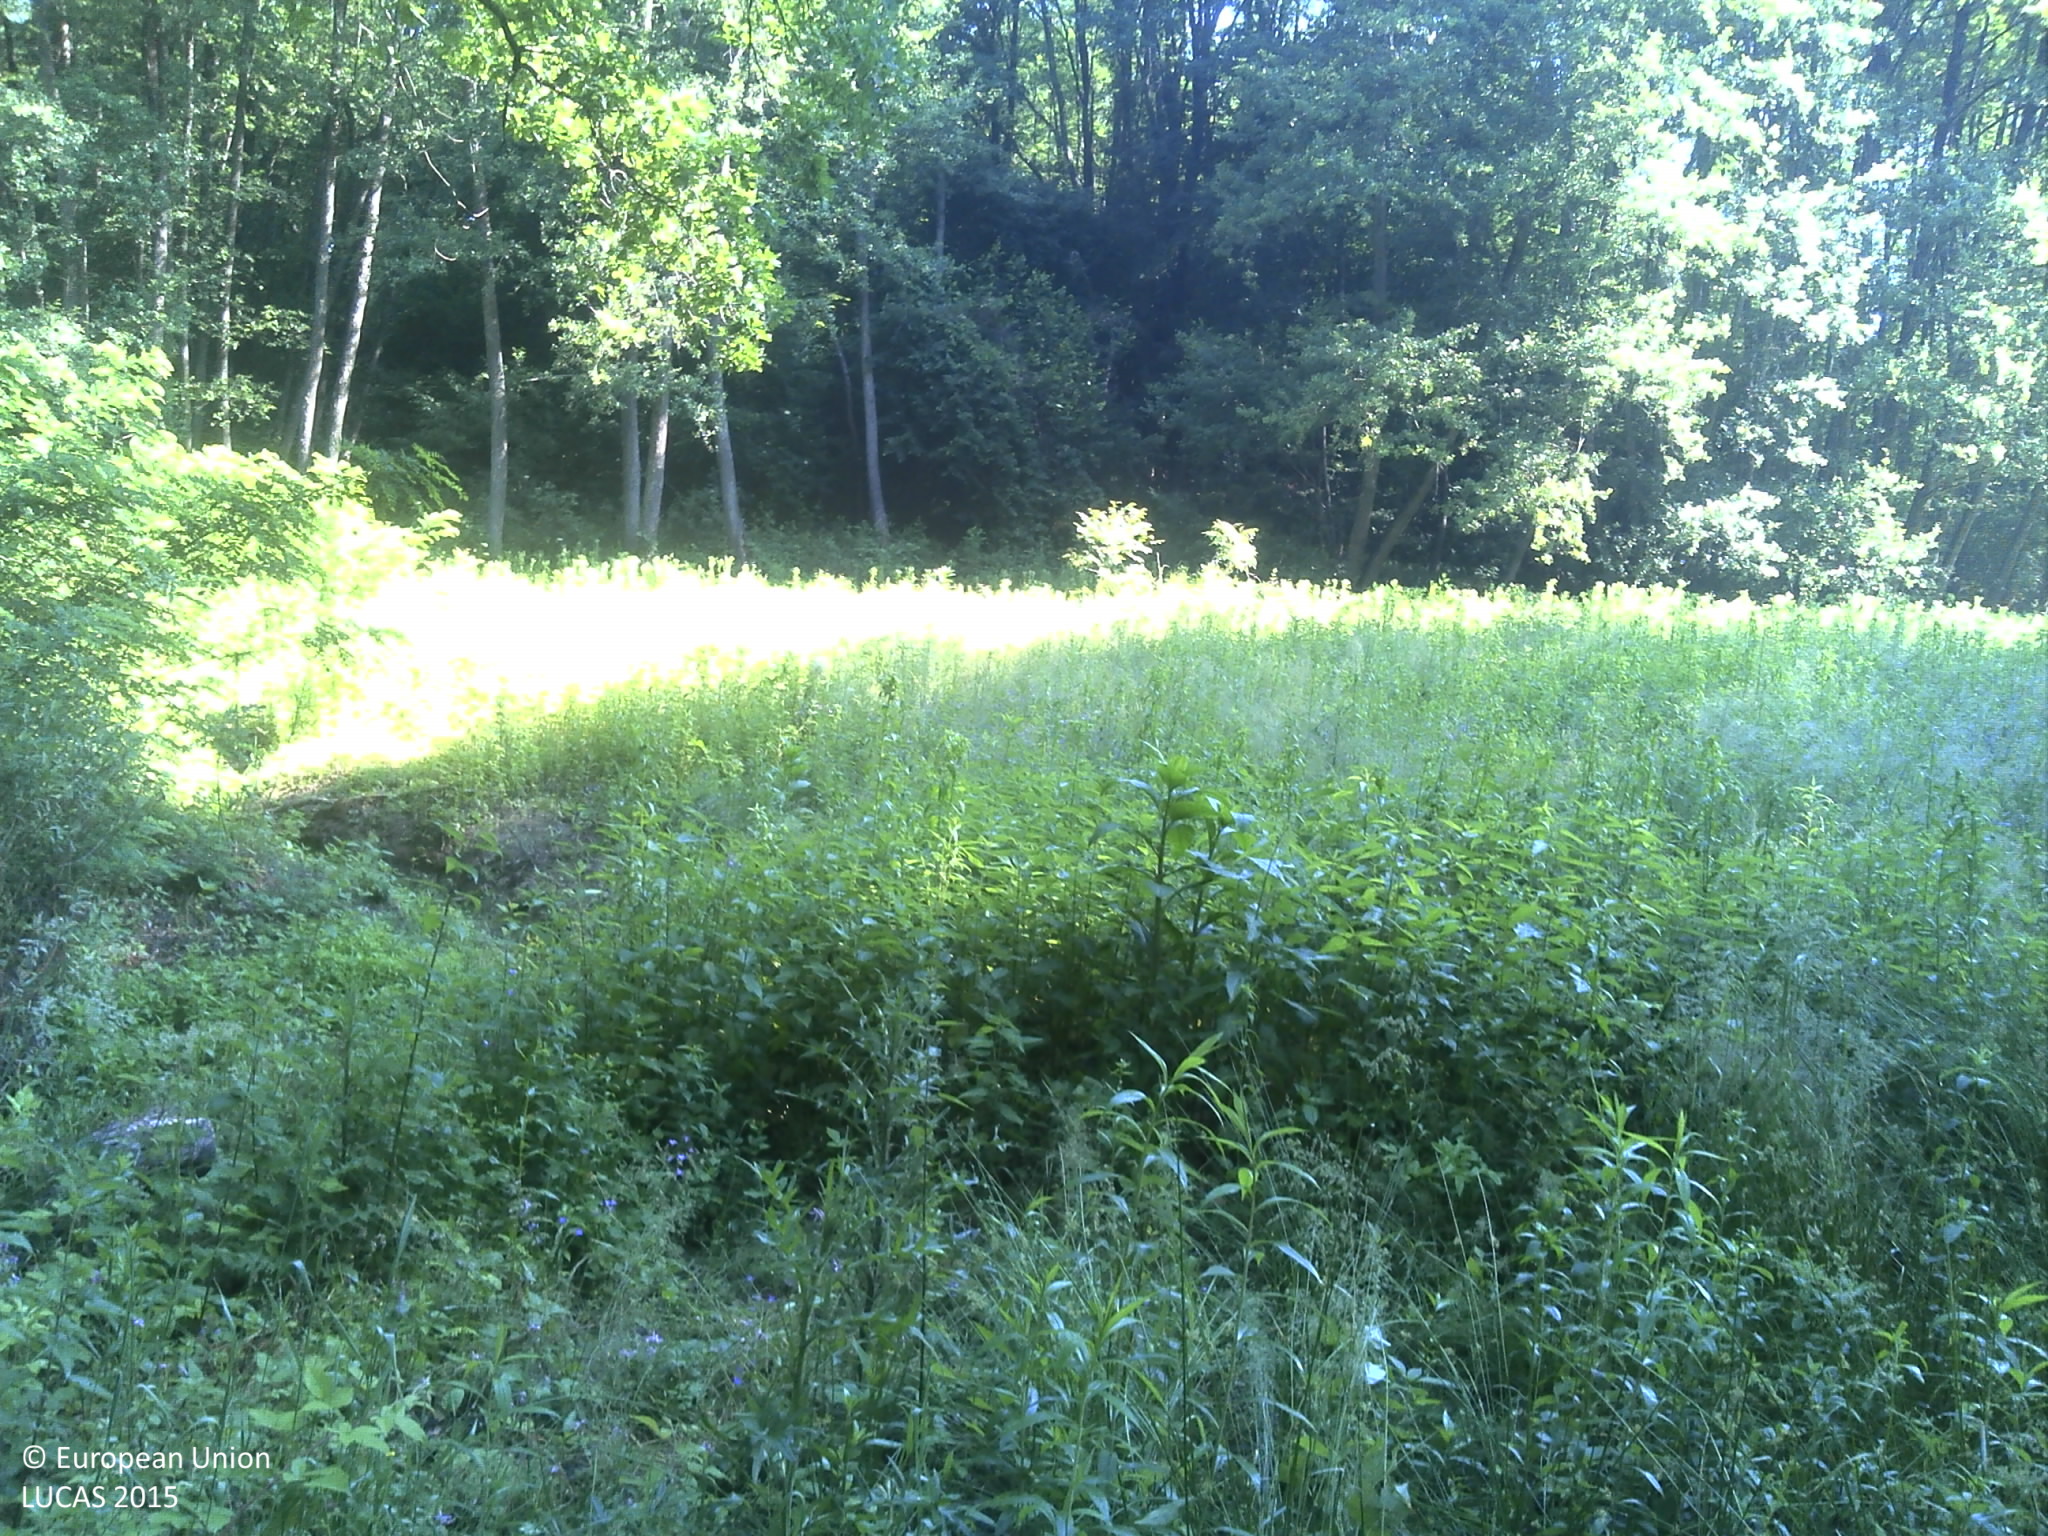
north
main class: Woodland
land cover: Broadleaved woodland
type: acidophilous oak and oak-birch forest
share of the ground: > 75 %
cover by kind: broadleaved forest trees 80 %, shrubs 15 %, herbaceous plants 5 %
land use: Forestry
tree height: > 5 m
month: June
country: HR
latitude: 45.6184
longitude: 17.7362
